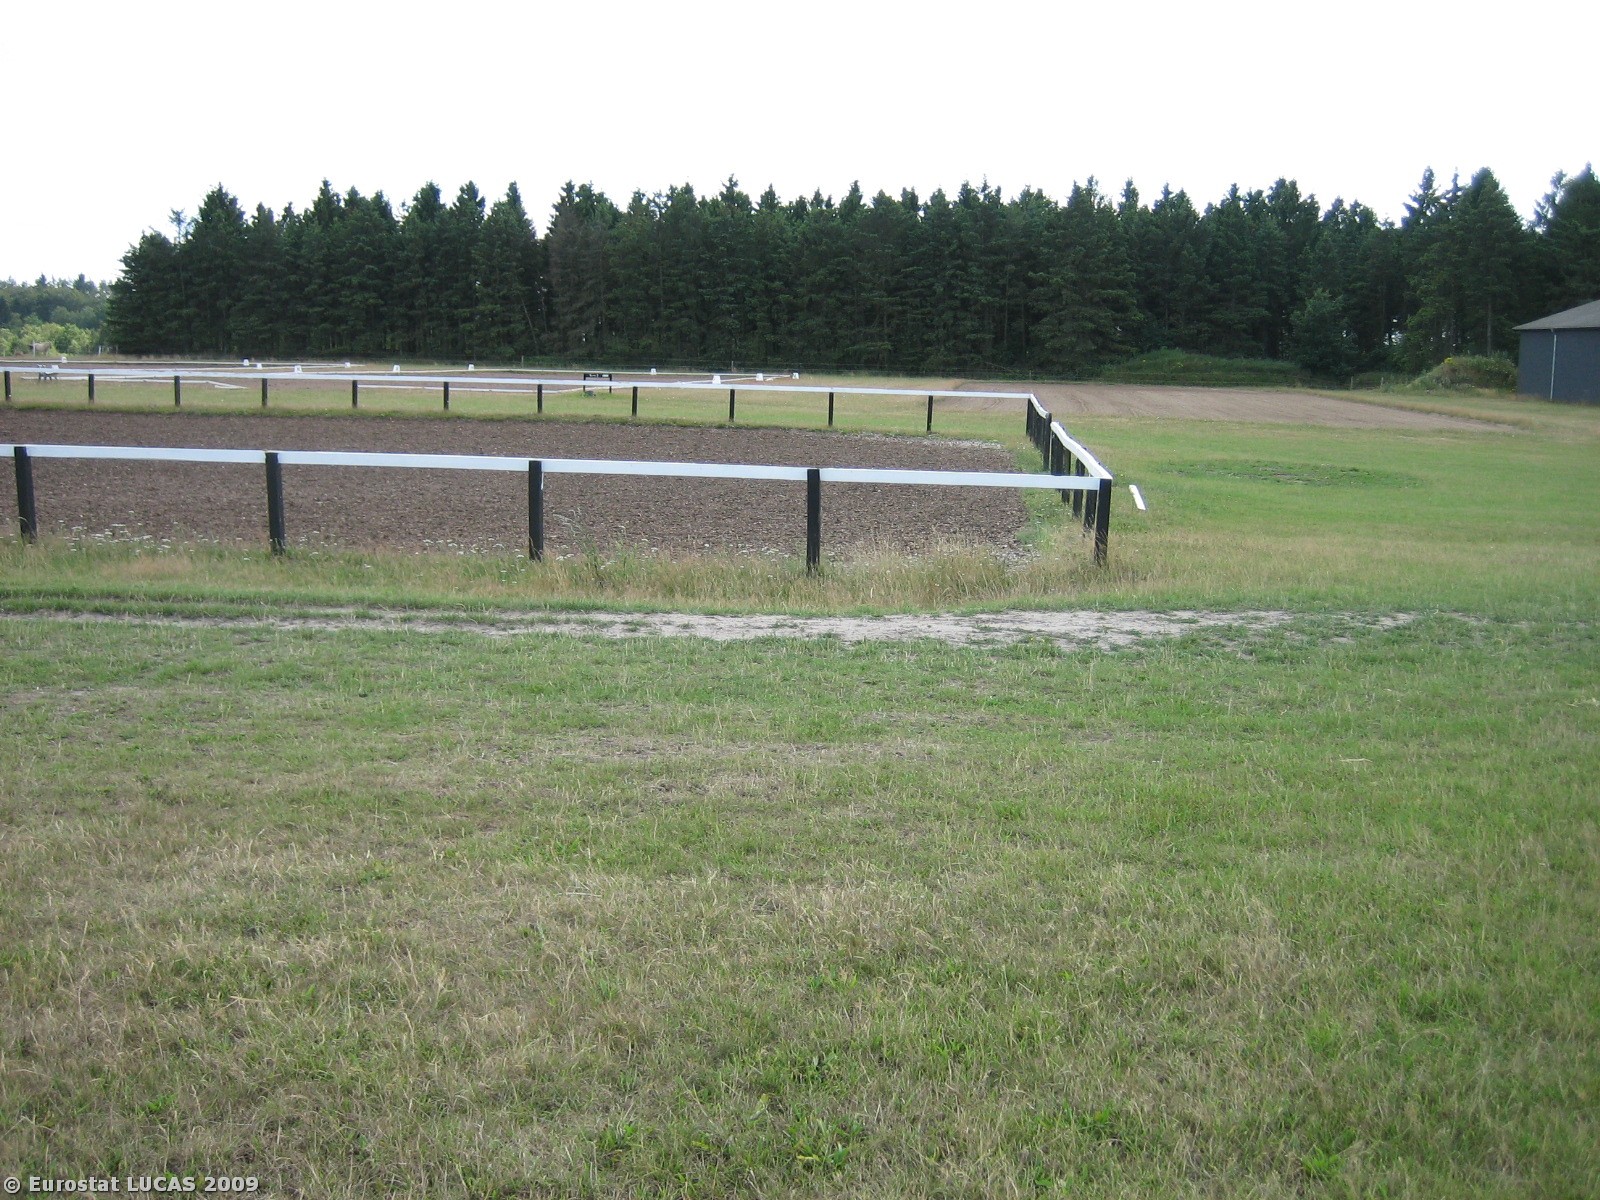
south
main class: Grassland
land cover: Grassland without tree/shrub cover
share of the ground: > 75 %
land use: Amenities, museums, leisure
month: July
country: DK
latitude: 55.7521
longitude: 8.9654
